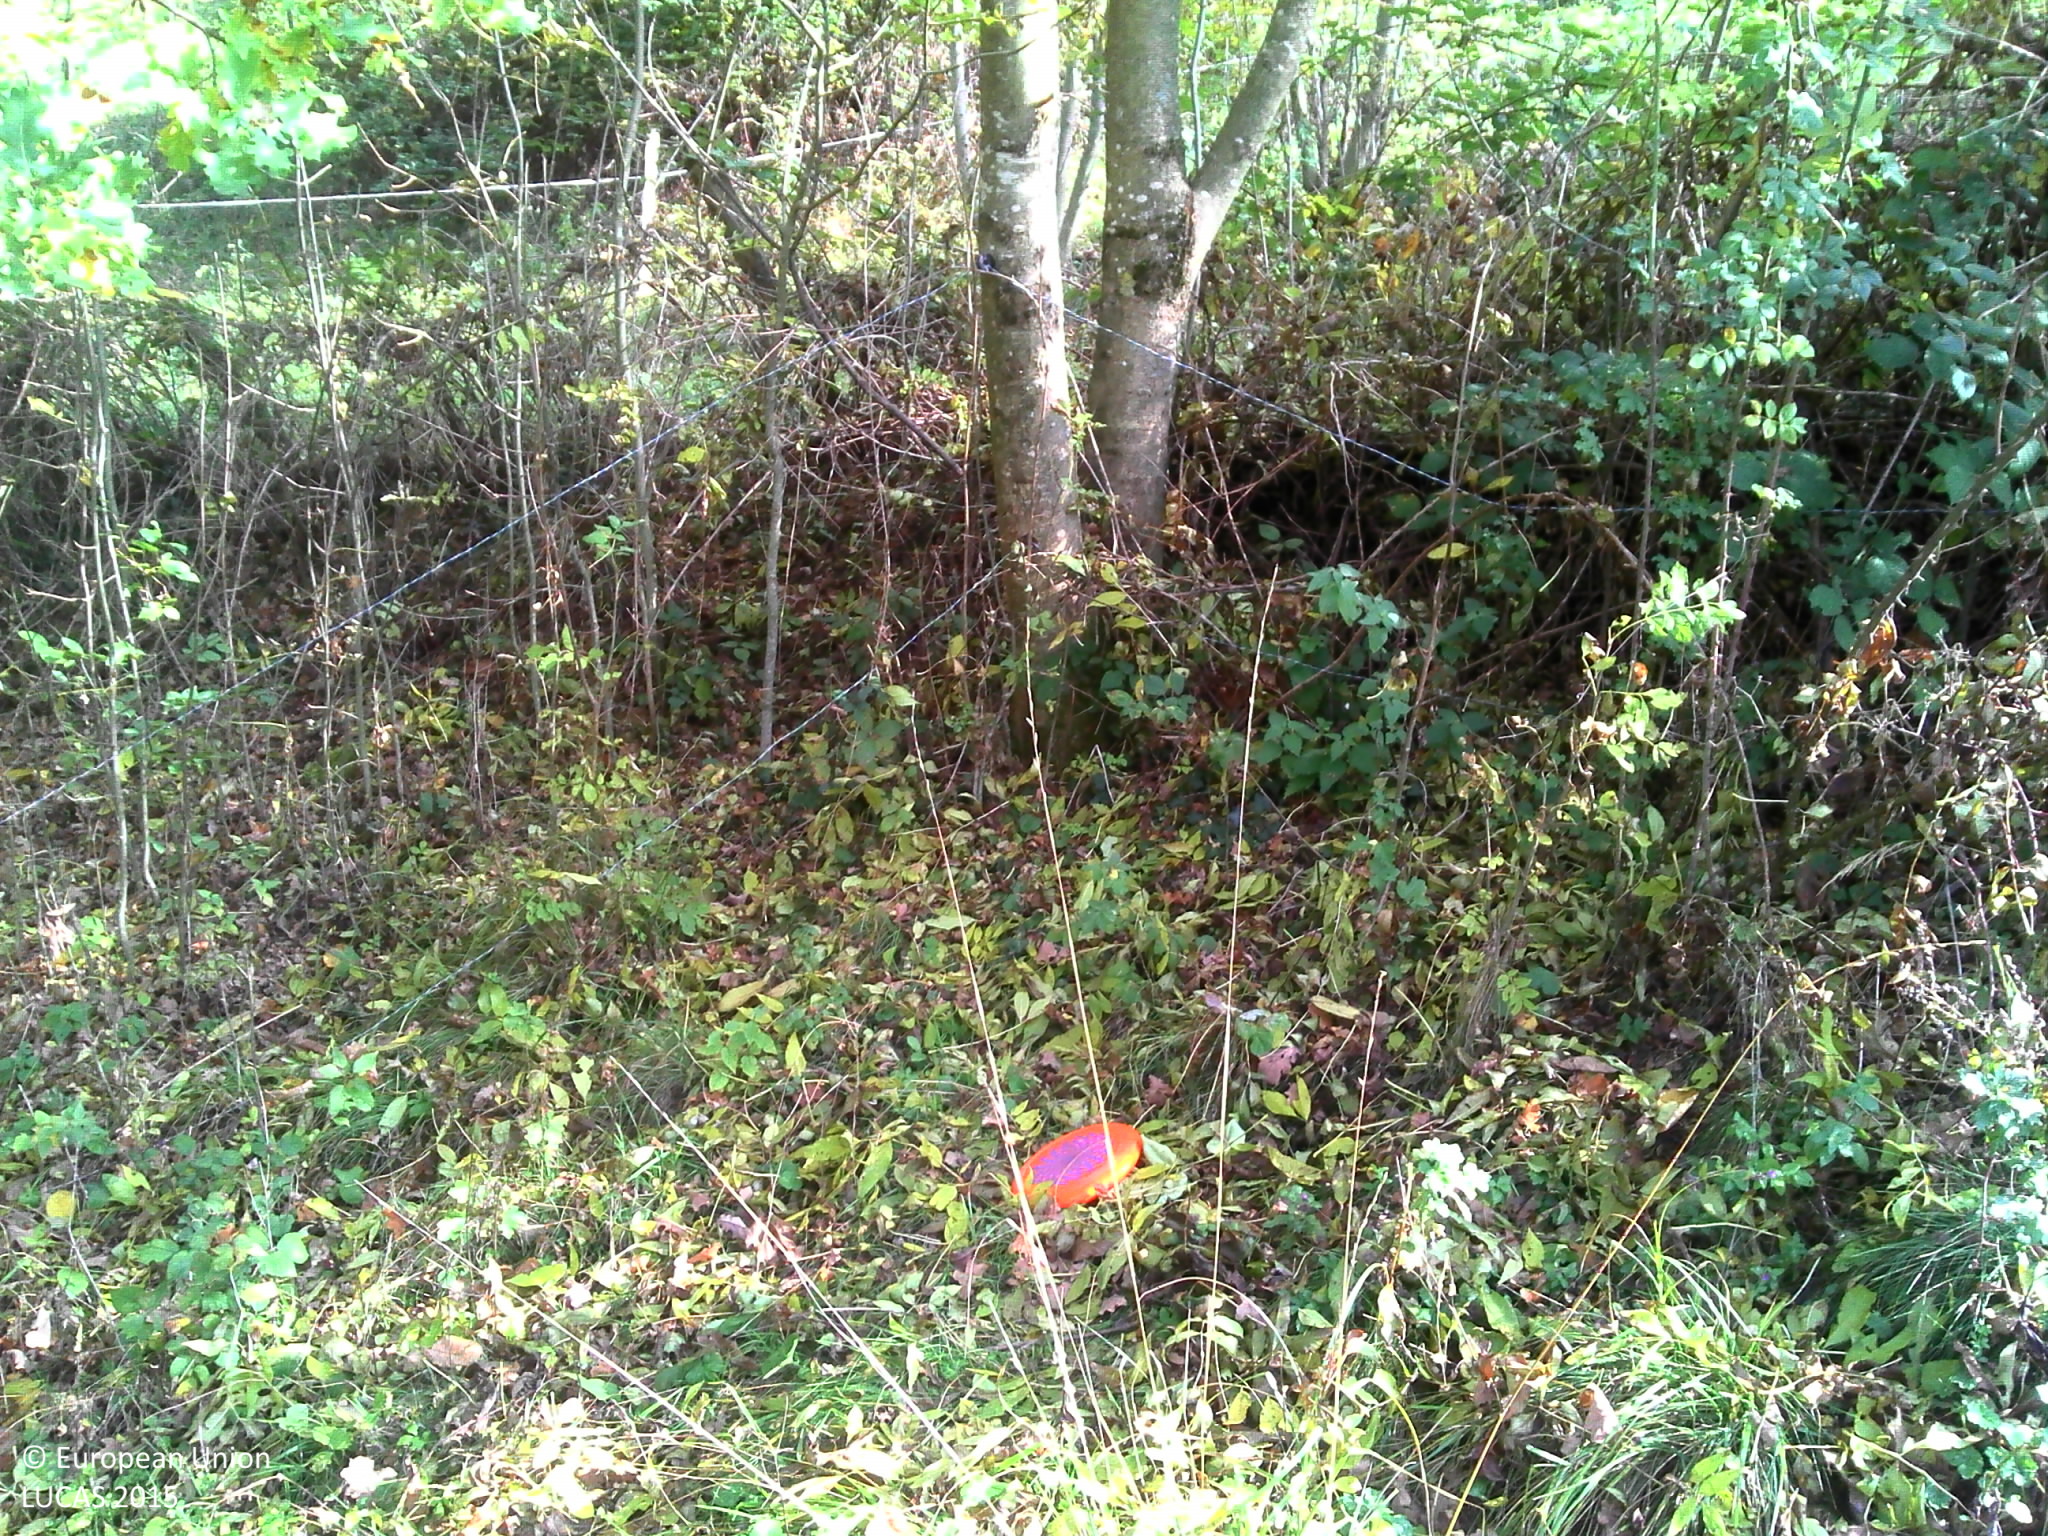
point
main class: Woodland
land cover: Broadleaved woodland
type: mesophytic deciduous forest
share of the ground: > 75 %
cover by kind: broadleaved forest trees 90 %, shrubs 5 %, consolidated bare surface 5 %
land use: Forestry
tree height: > 5 m
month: October
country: FR
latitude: 45.4031
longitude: 6.2871
